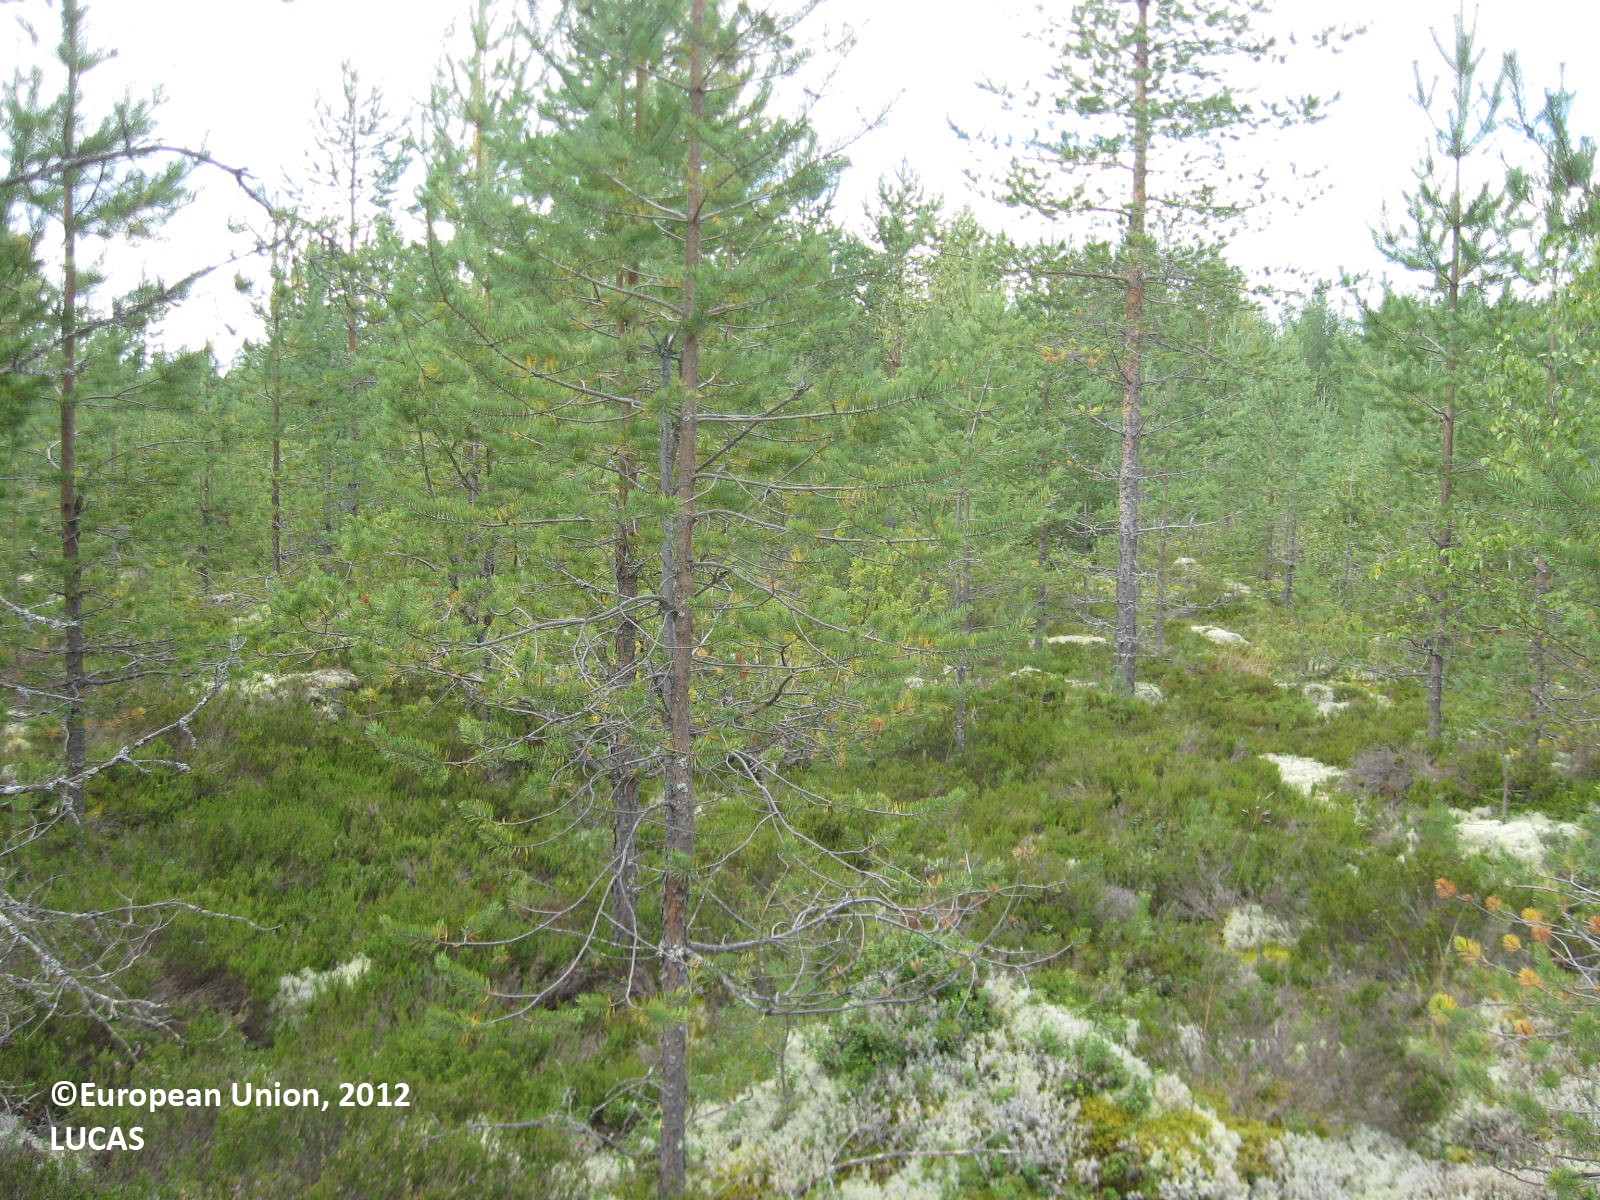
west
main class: Woodland
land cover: Pine dominated coniferous woodland
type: boreal forest
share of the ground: 50 - 75 %
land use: Forestry
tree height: > 5 m
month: August
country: FI
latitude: 63.4782
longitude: 30.2722
